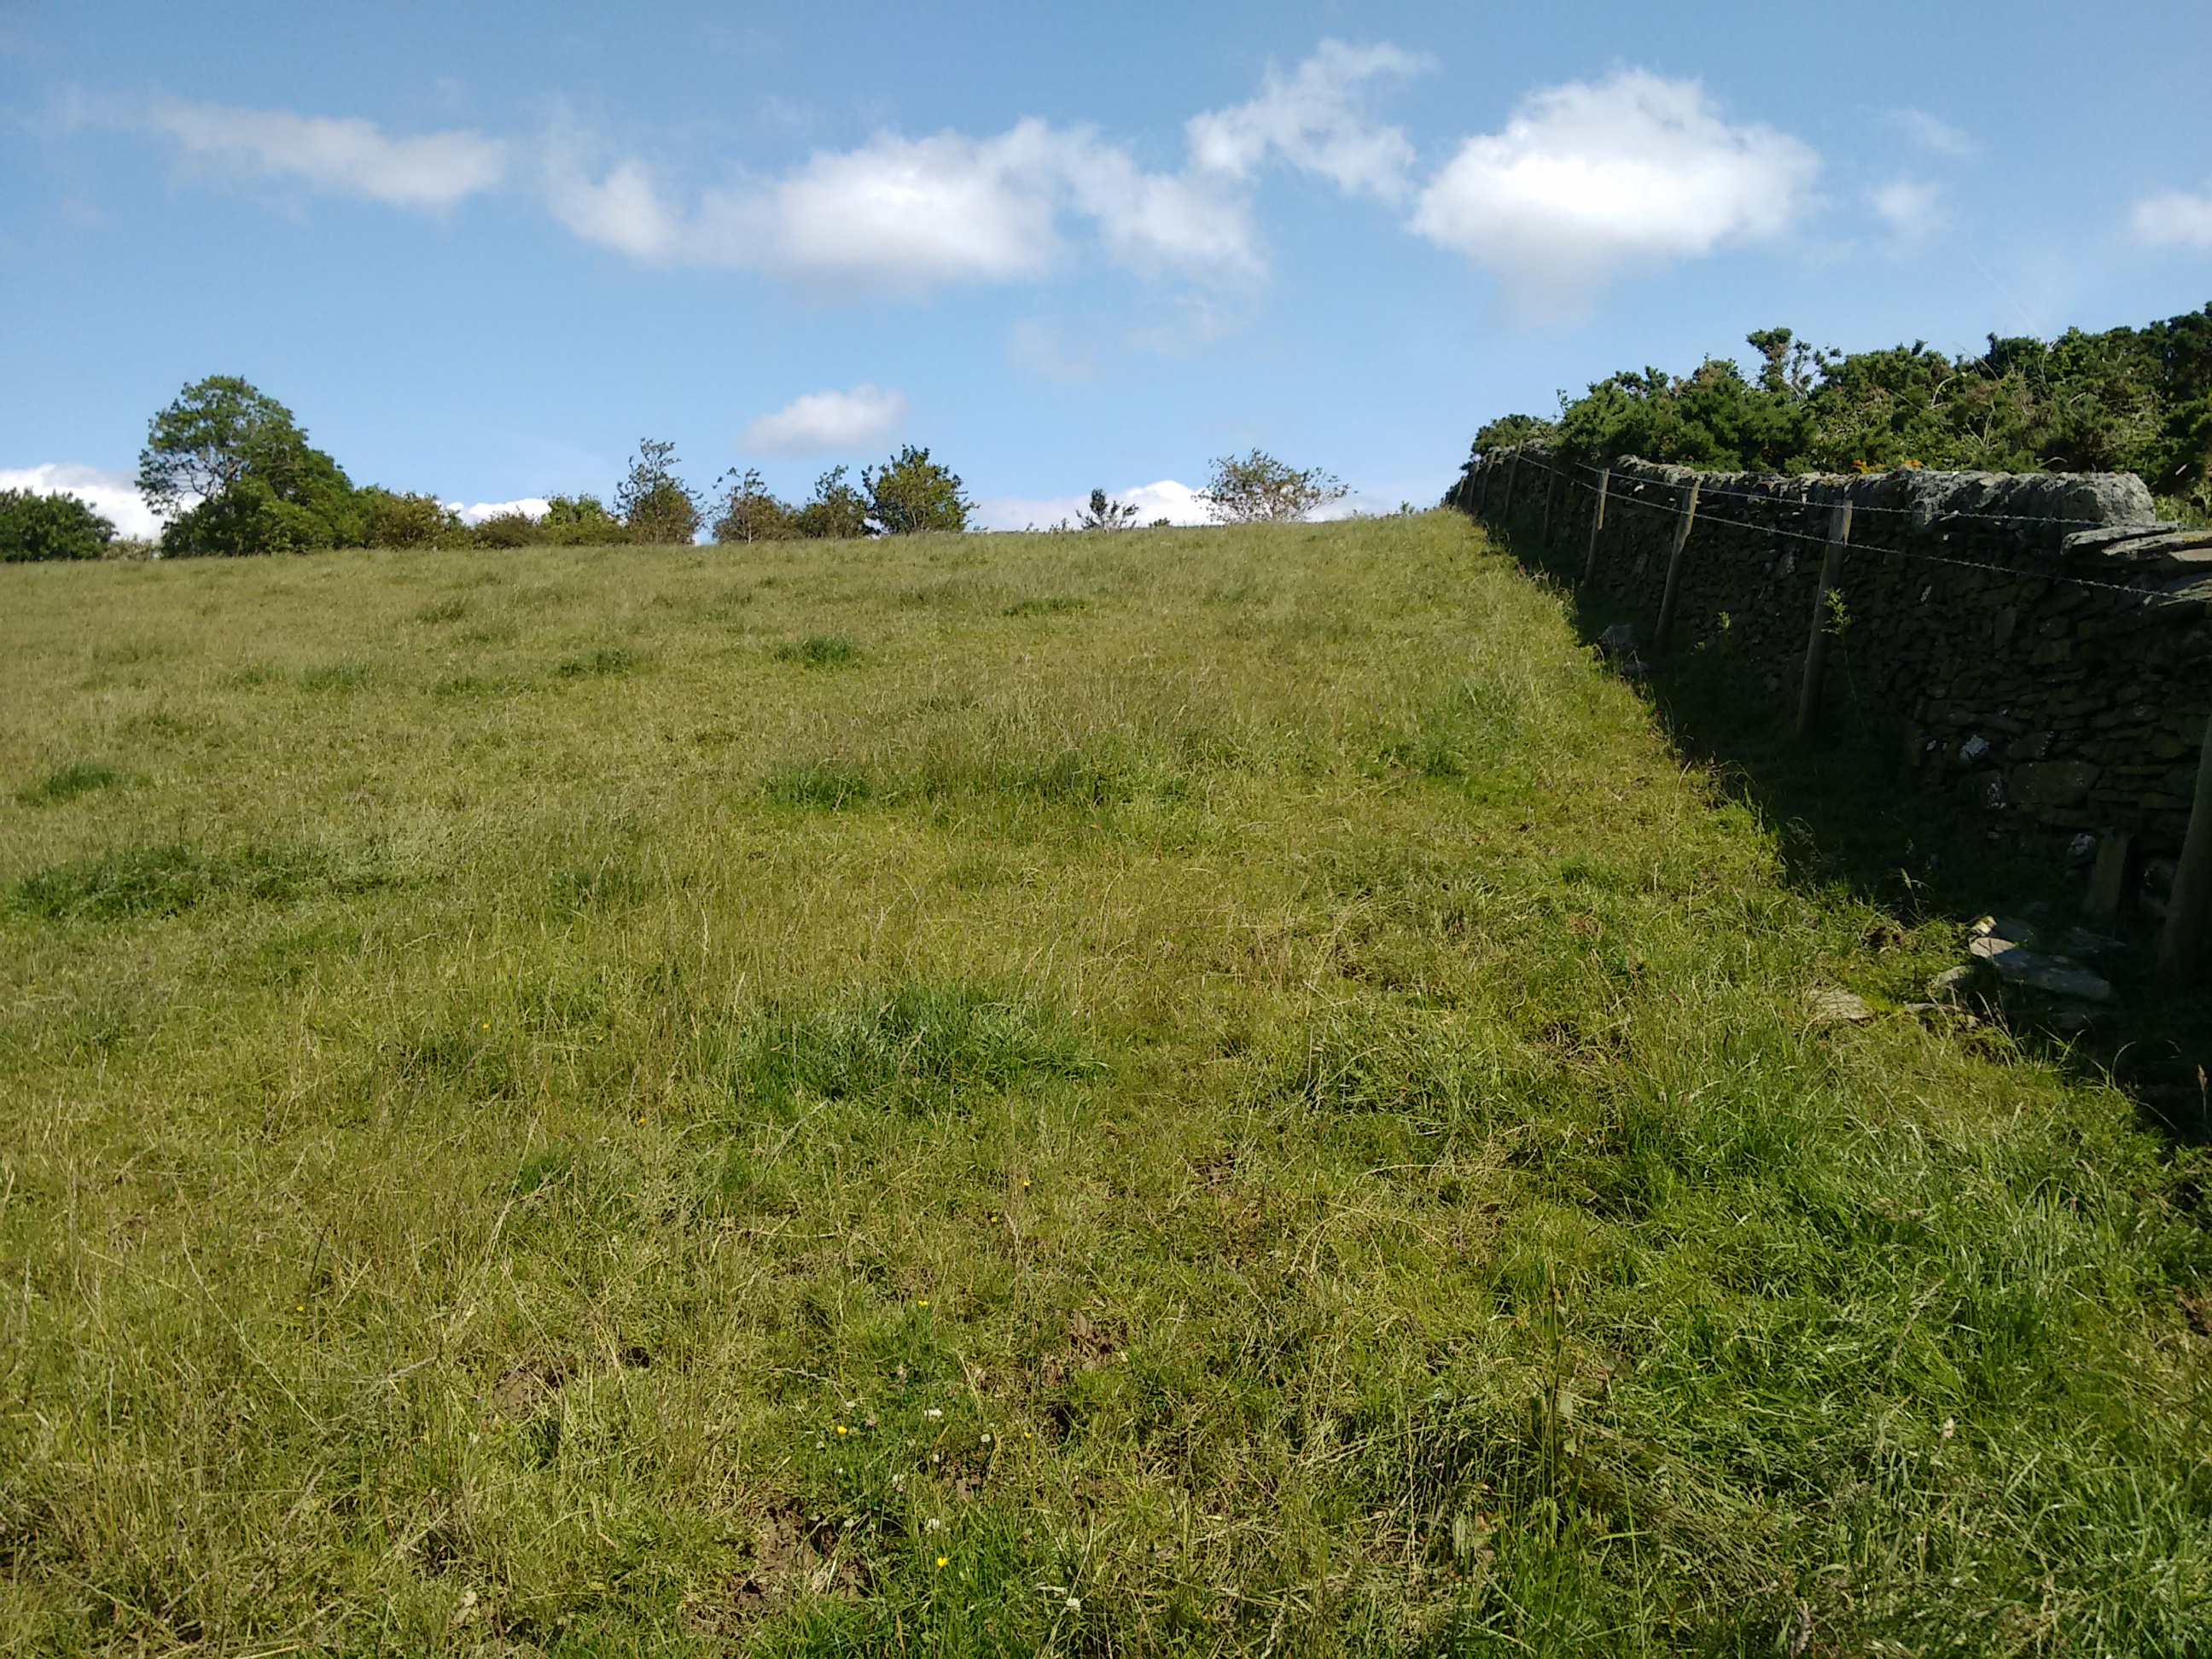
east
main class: Grassland
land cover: Grassland without tree/shrub cover
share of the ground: > 75 %
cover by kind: herbaceous plants 95 %, shrubs 5 %
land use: Agriculture (excluding fallow land and kitchen gardens)
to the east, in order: Grassland without tree/shrub cover; Shrubland with sparse tree cover; Dry stone walls; Grass margins; Paved roads, cycling and walking lanes; Grass margins; Managed hedges; Grassland without tree/shrub cover
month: July
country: GB
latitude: 55.8183
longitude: -5.0993
